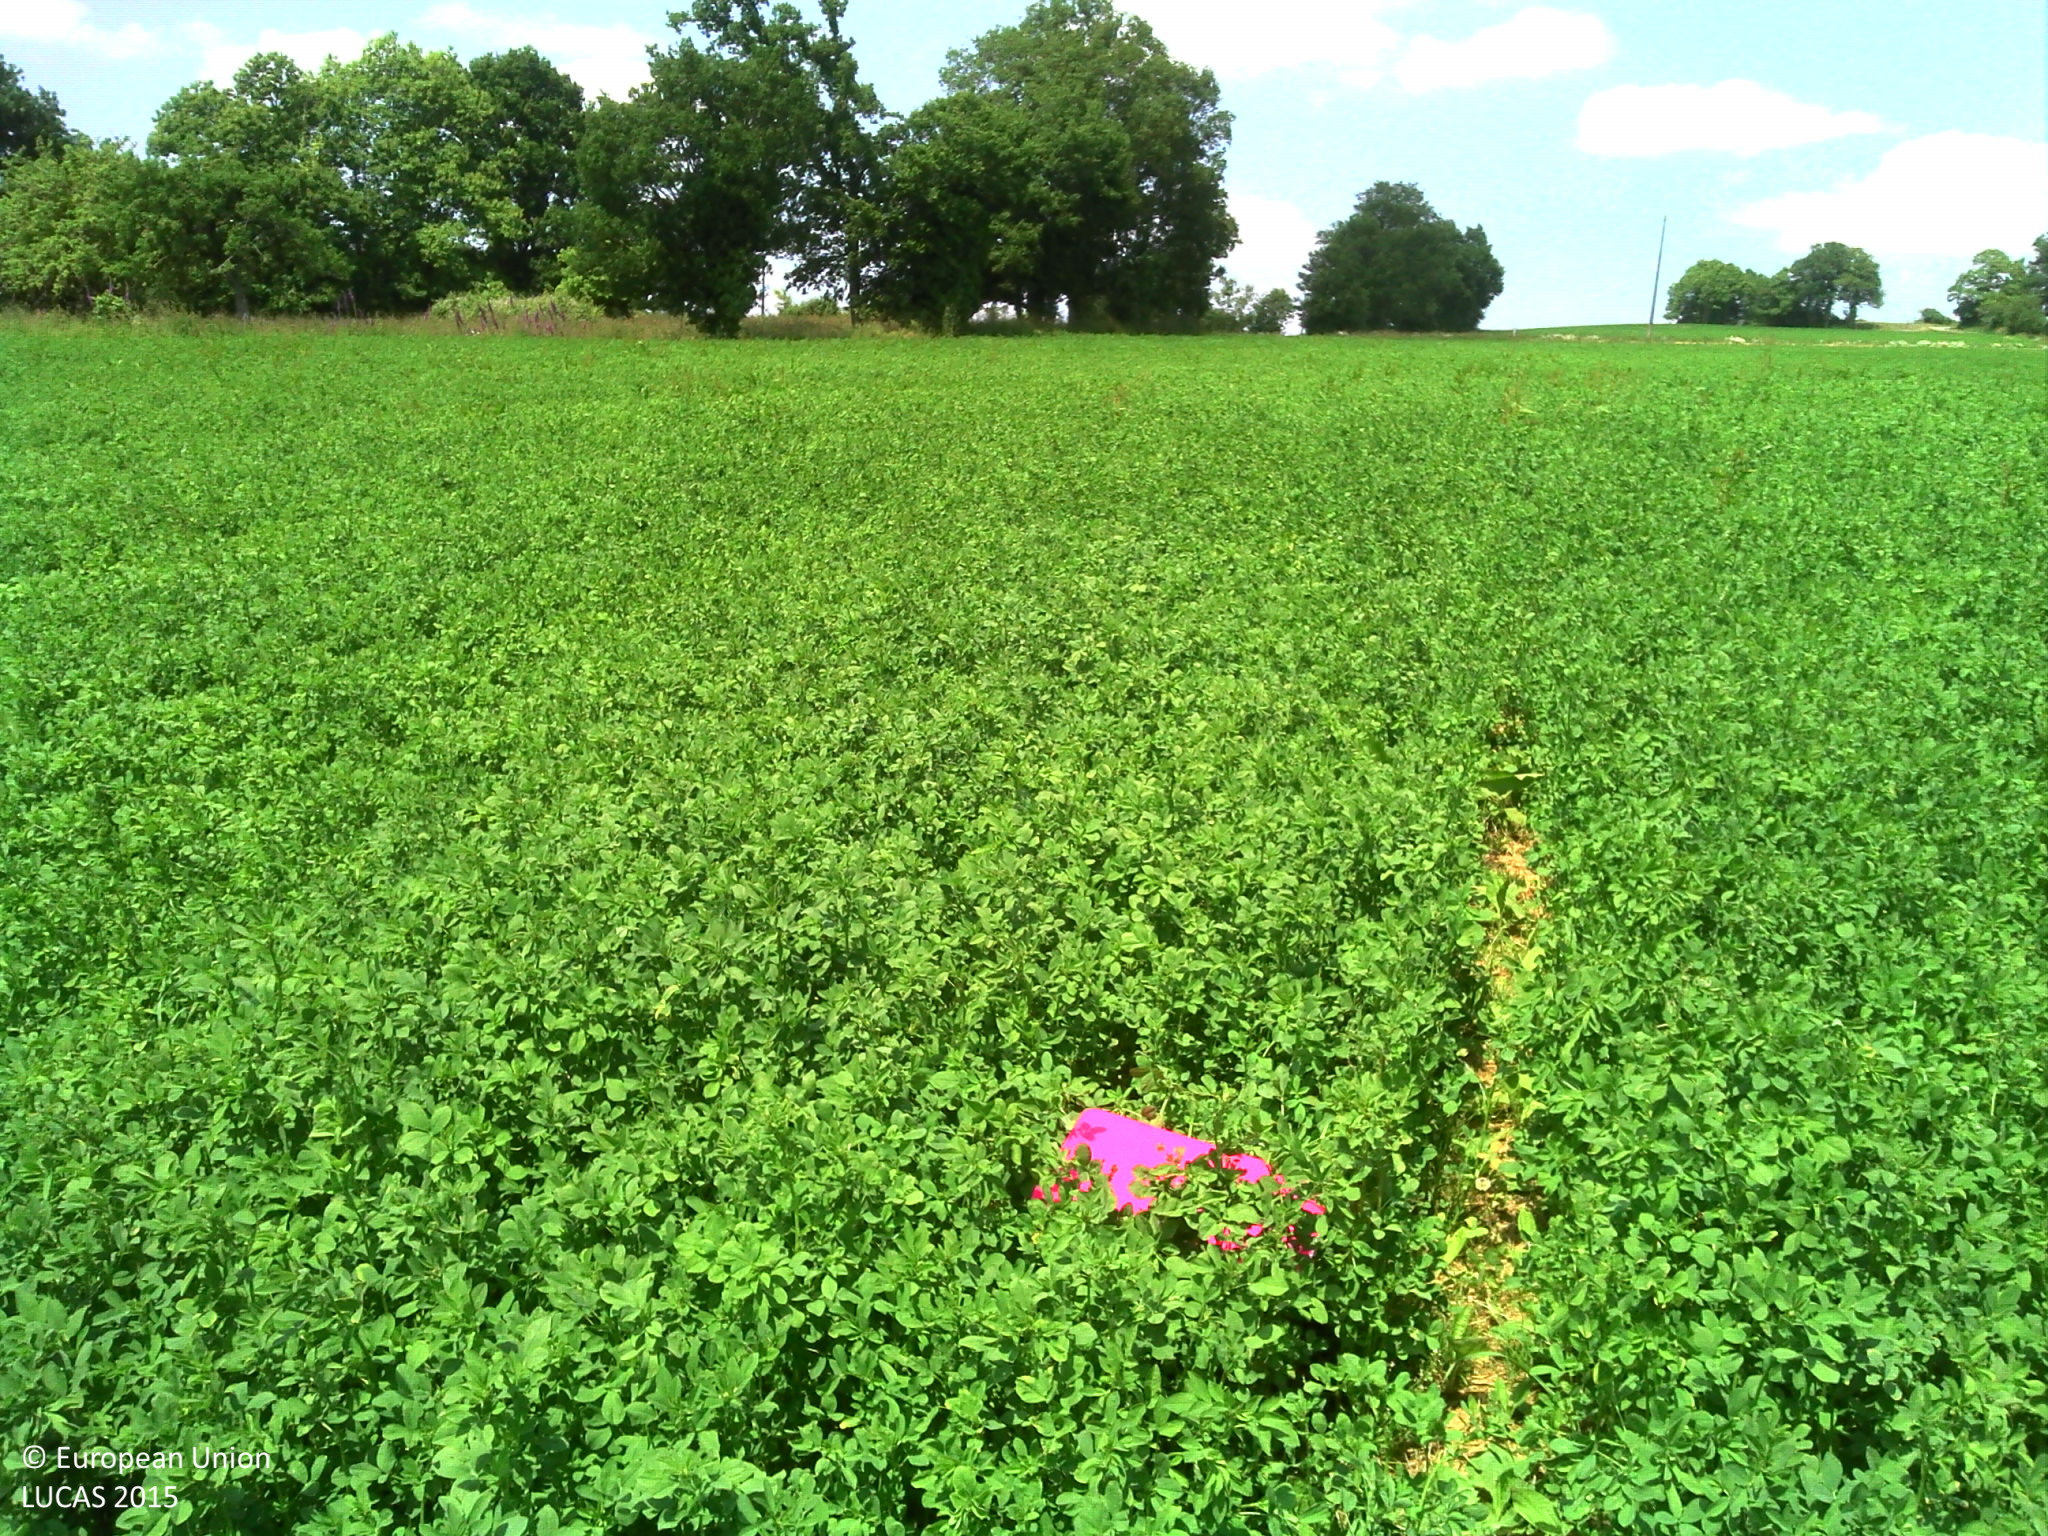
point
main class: Cropland
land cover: Lucerne
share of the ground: > 75 %
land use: Agriculture (excluding fallow land and kitchen gardens)
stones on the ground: < 10 %
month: June
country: FR
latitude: 48.1840
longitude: -1.1378
